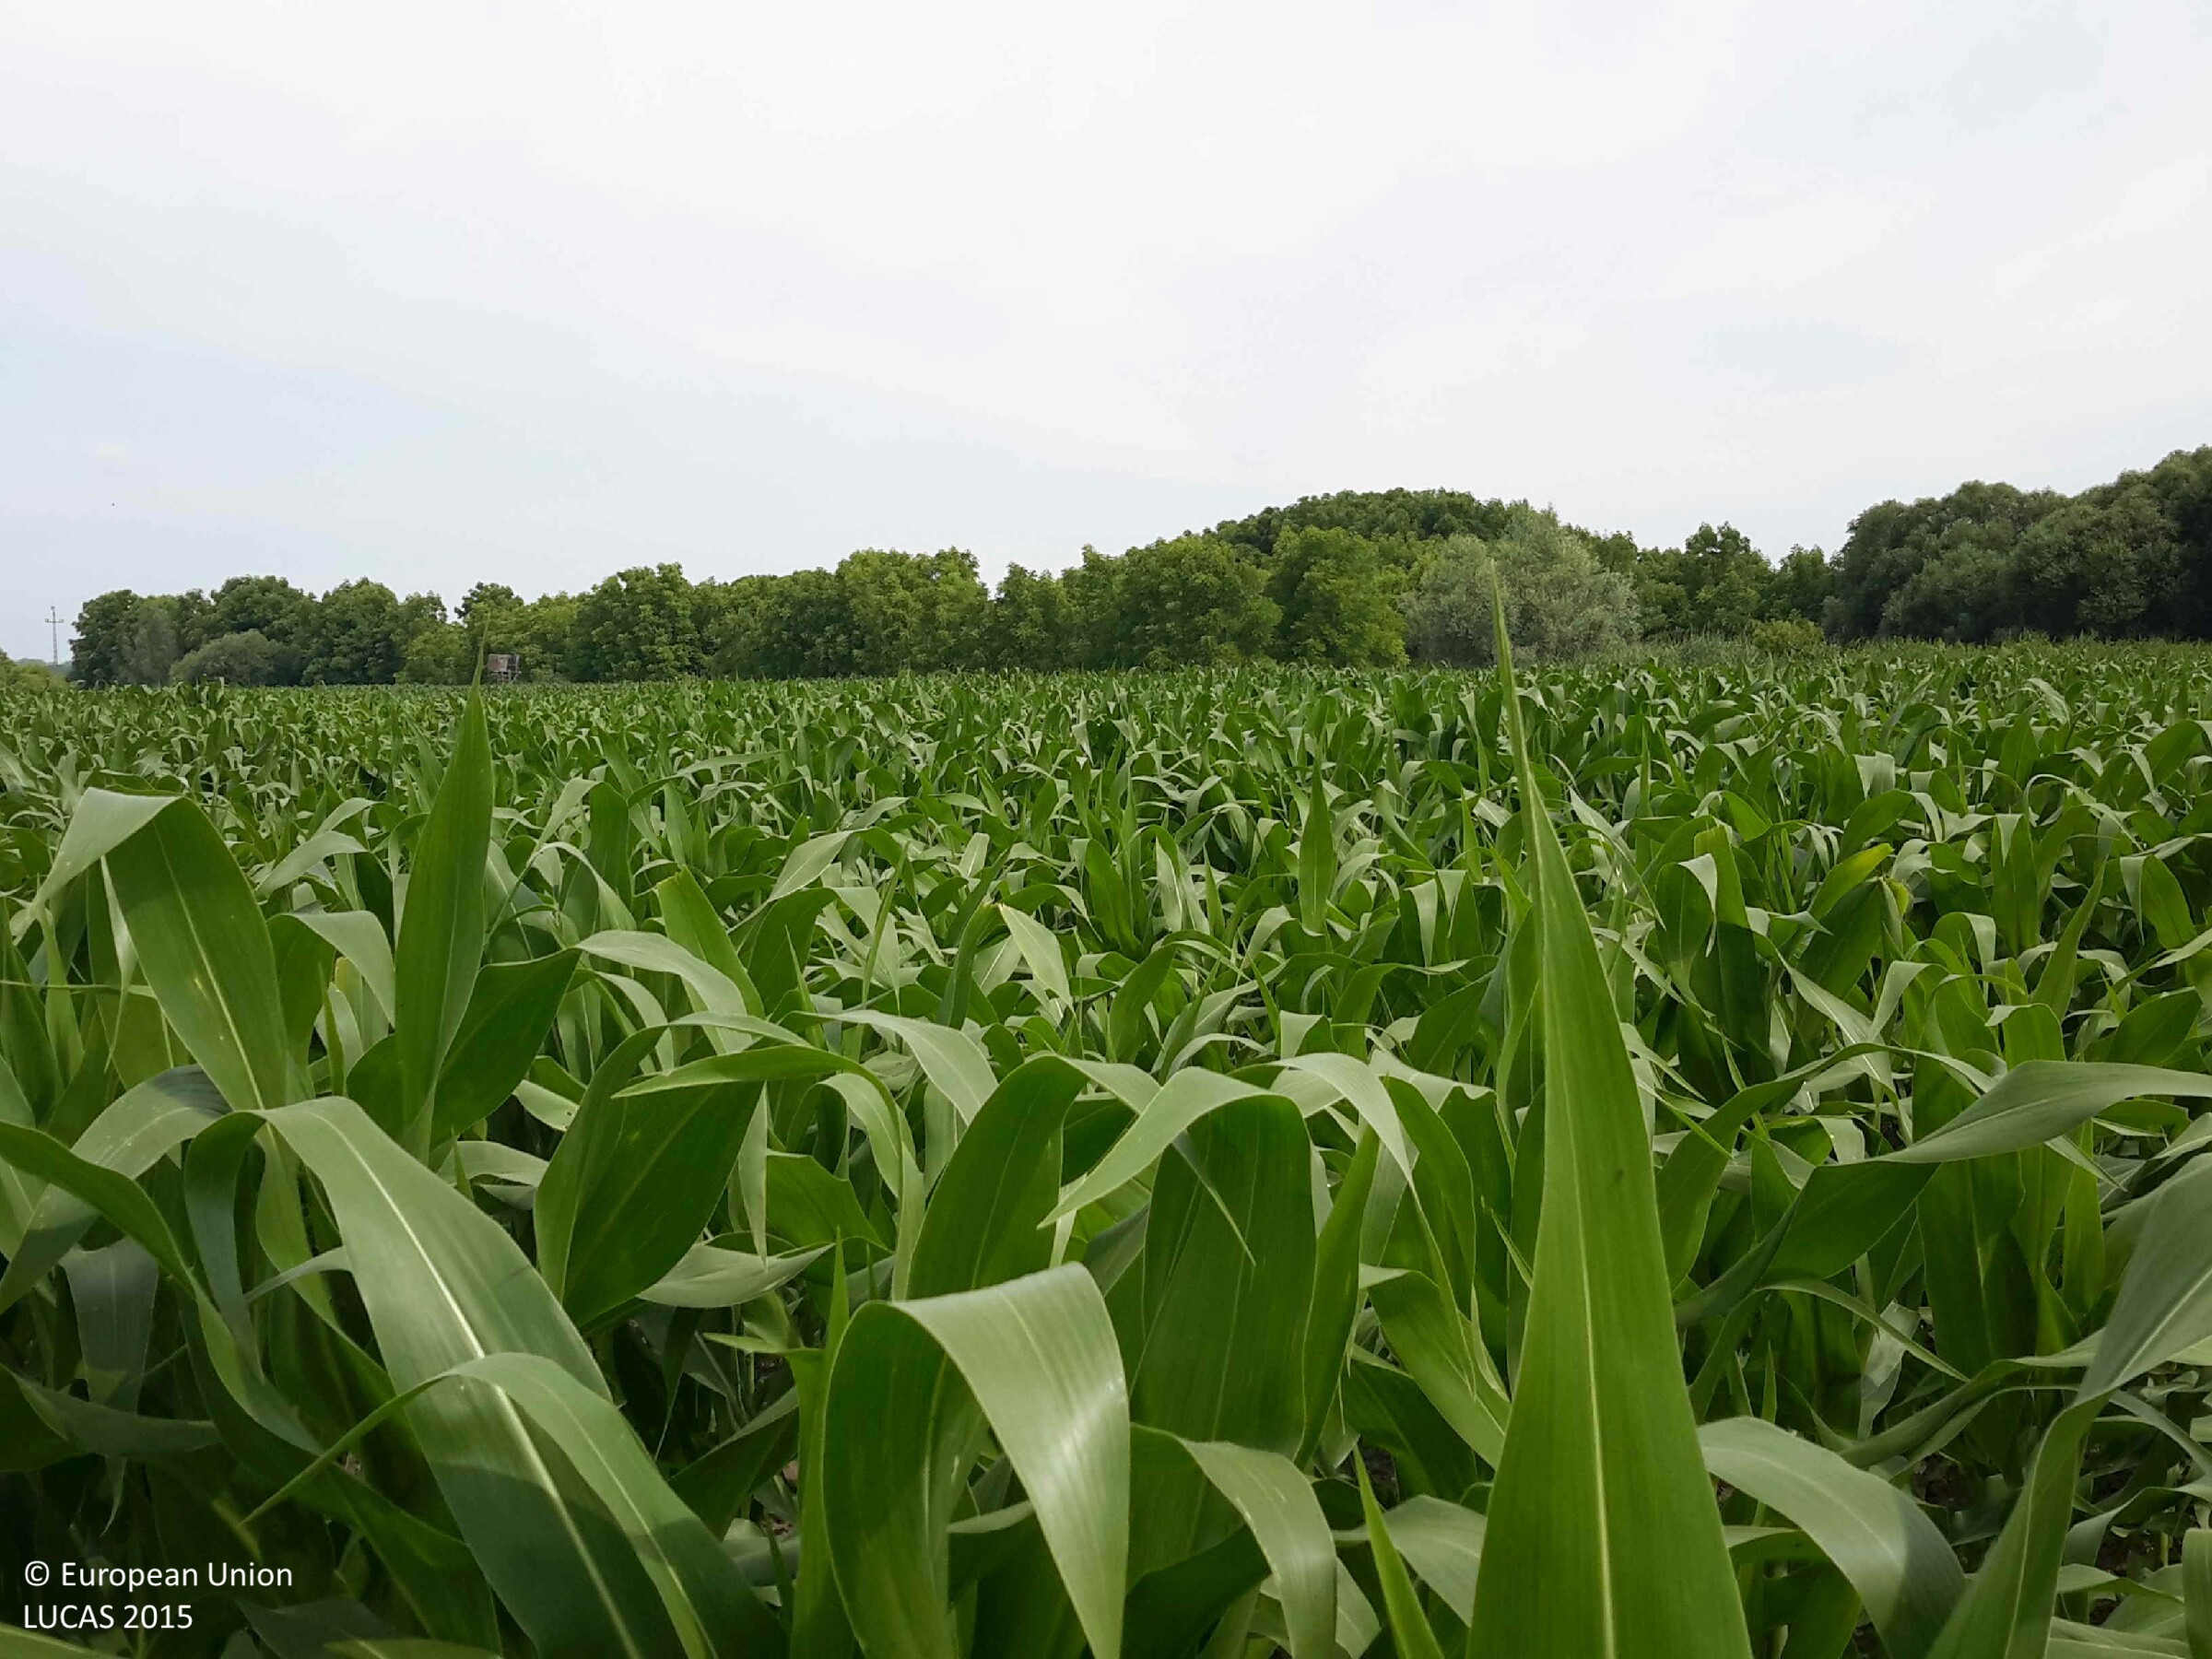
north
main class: Cropland
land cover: Maize
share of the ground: > 75 %
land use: Agriculture (excluding fallow land and kitchen gardens)
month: June
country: HU
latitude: 47.3345
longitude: 17.5112
